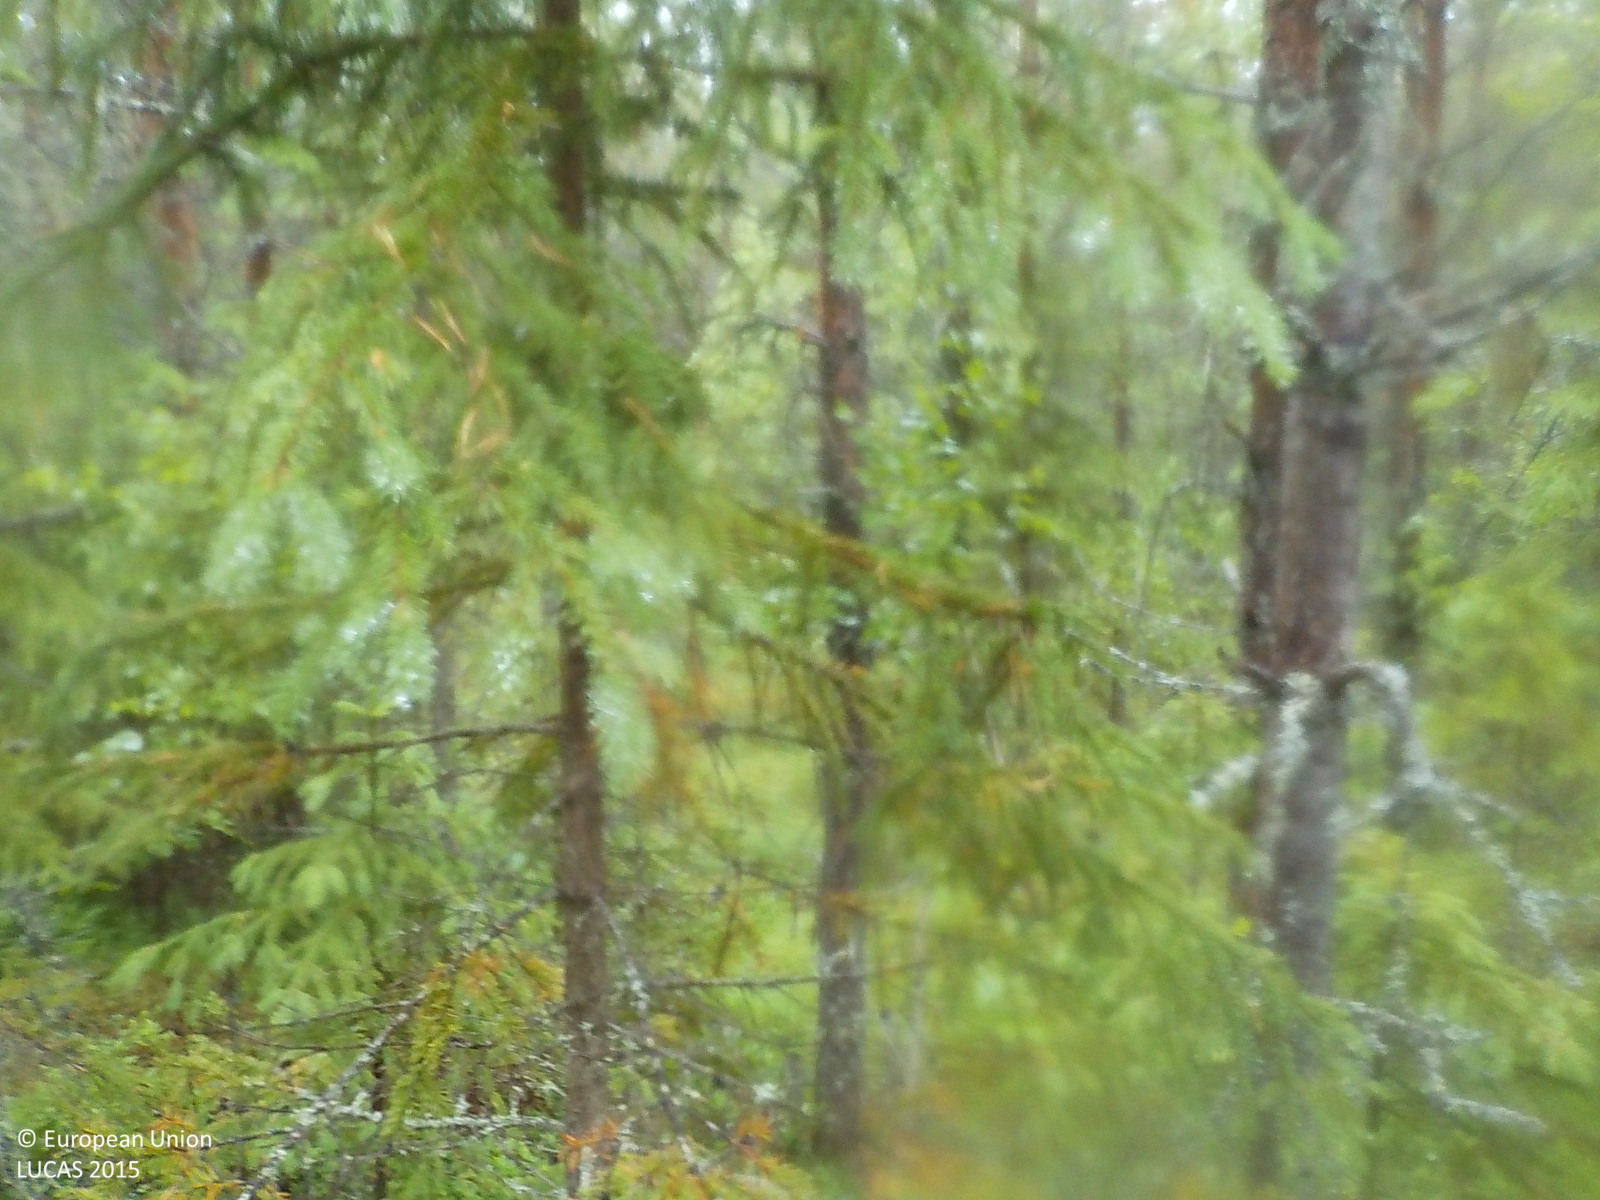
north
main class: Woodland
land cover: Pine dominated coniferous woodland
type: boreal forest
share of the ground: > 75 %
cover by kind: coniferous forest trees 75 %, lichens and mosses 15 %, shrubs 5 %, herbaceous plants 5 %
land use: Forestry
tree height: > 5 m
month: July
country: SE
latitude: 63.0151
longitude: 16.9101
